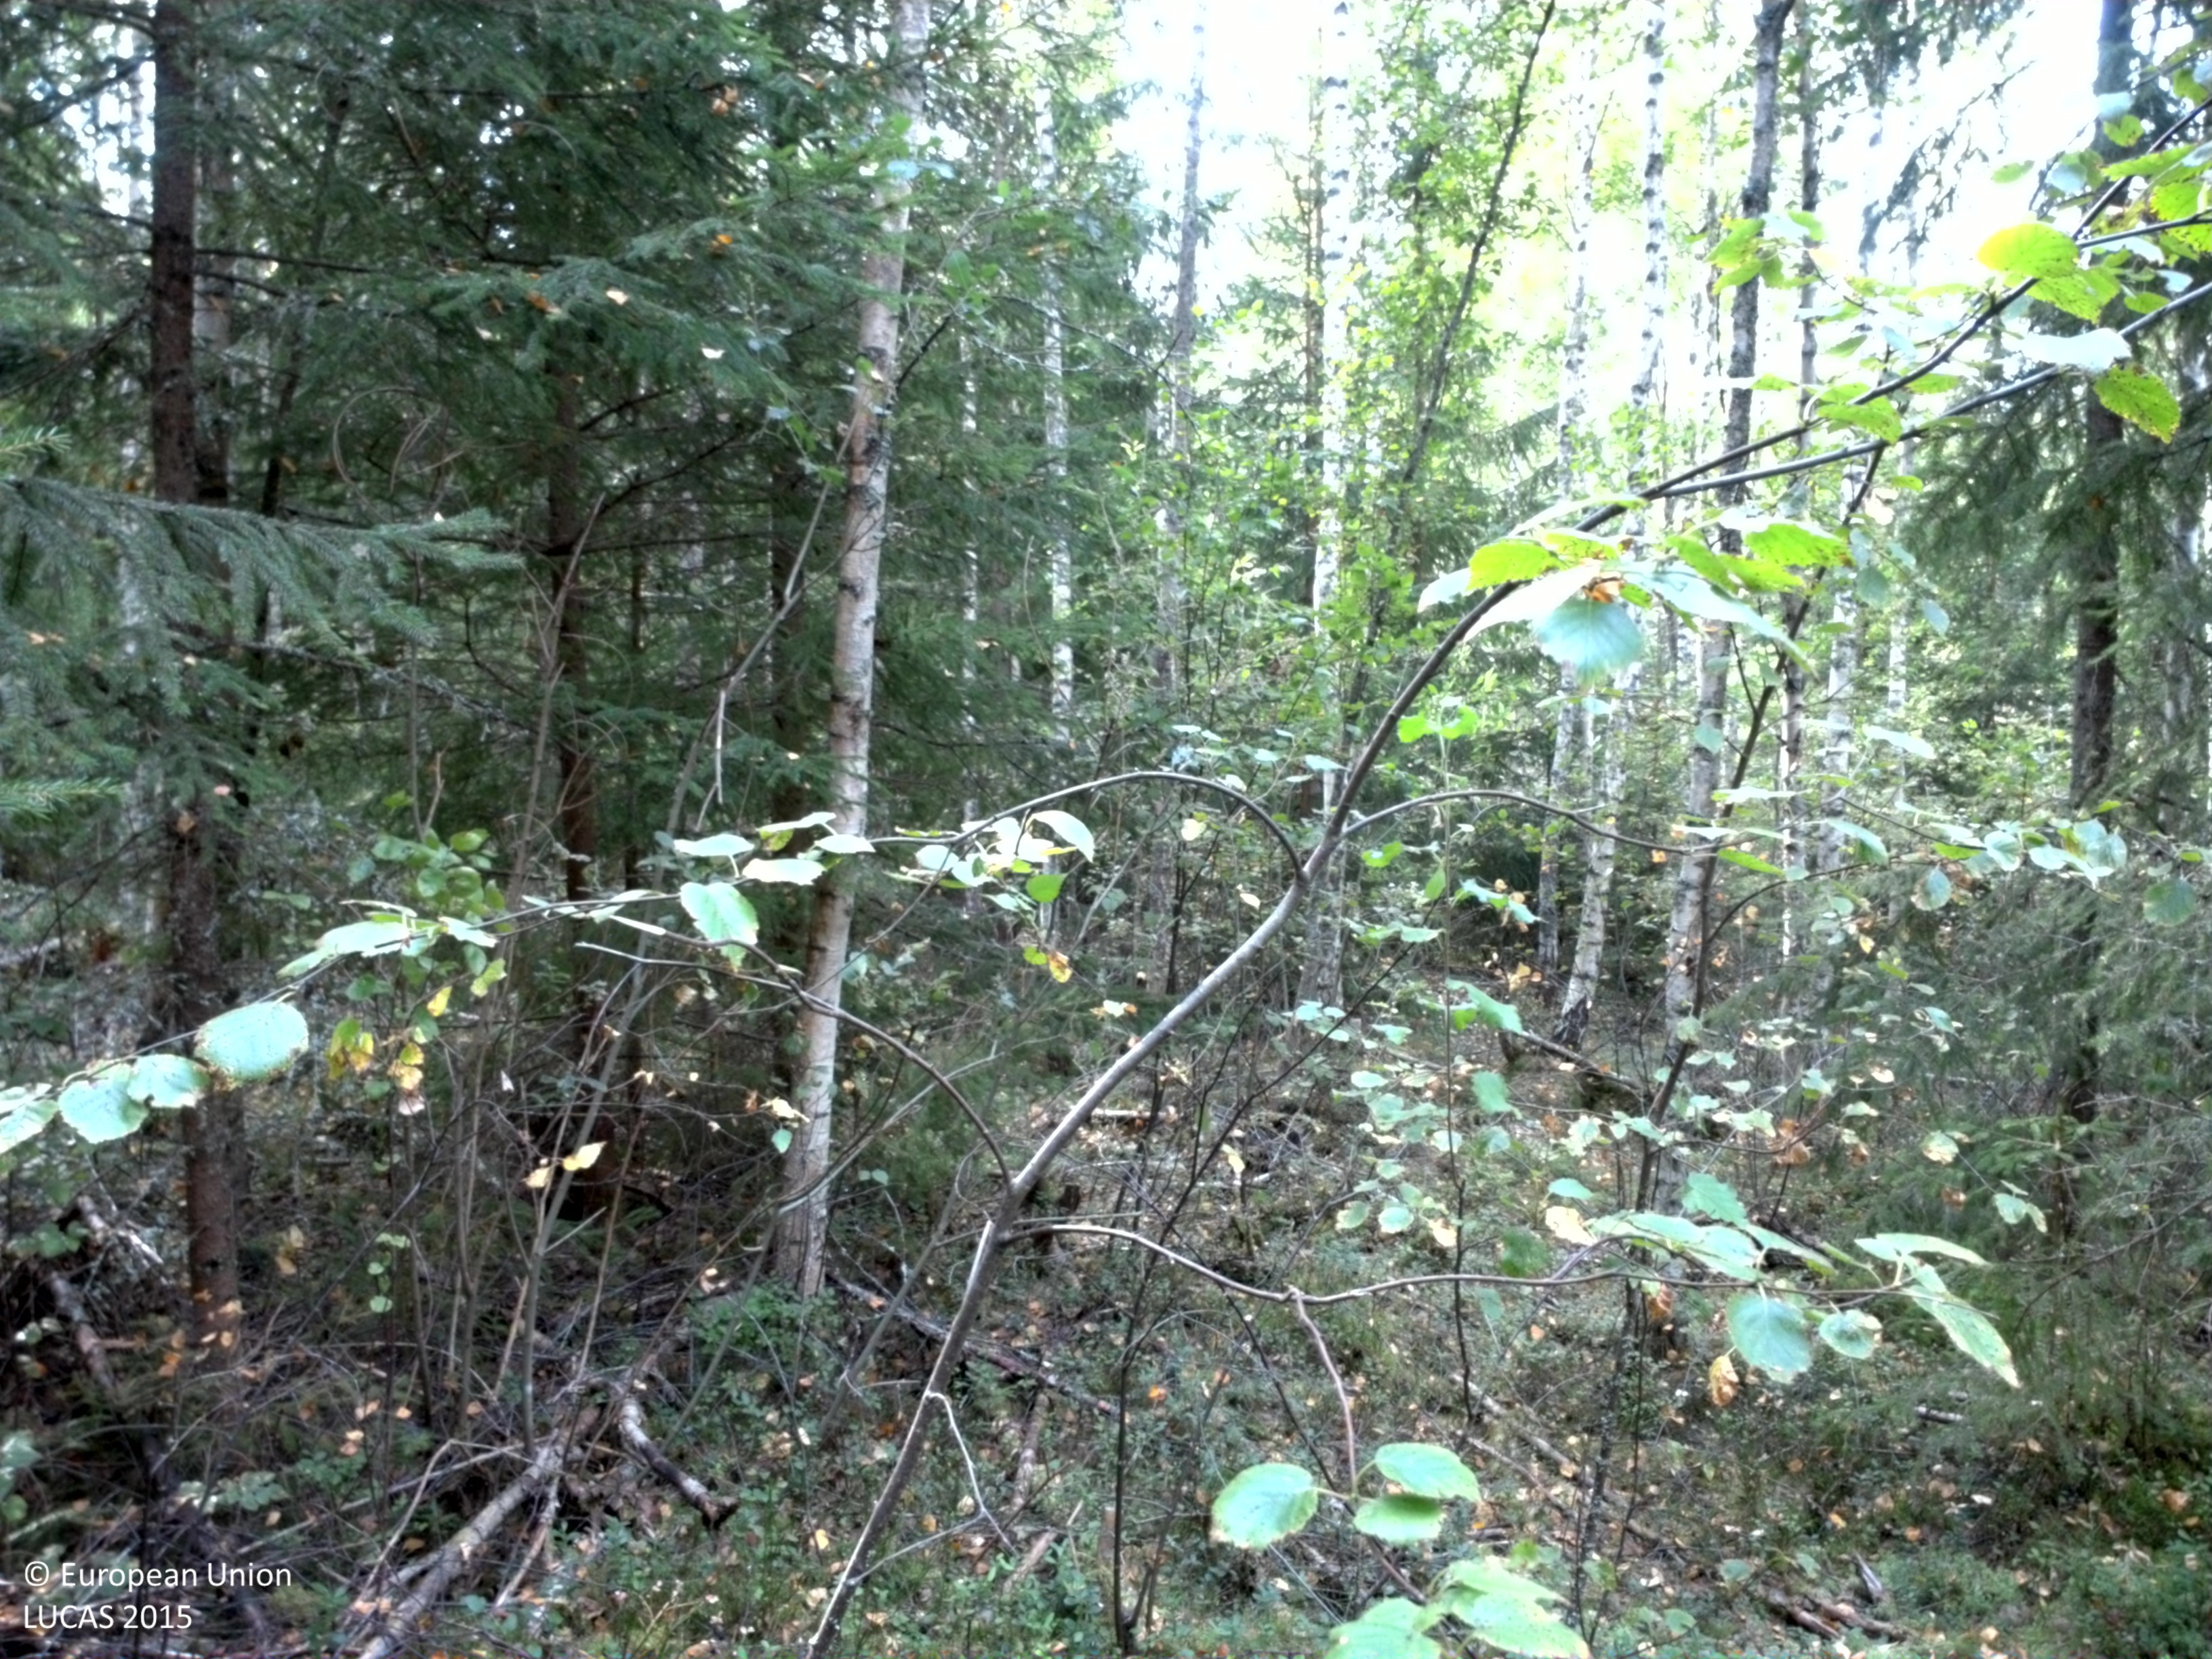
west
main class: Woodland
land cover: Pine dominated mixed woodland
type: boreal forest
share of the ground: 50 - 75 %
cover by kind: coniferous forest trees 55 %, broadleaved forest trees 20 %, lichens and mosses 20 %, shrubs 5 %
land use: Forestry
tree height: > 5 m
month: August
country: SE
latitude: 59.6160
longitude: 13.4481
